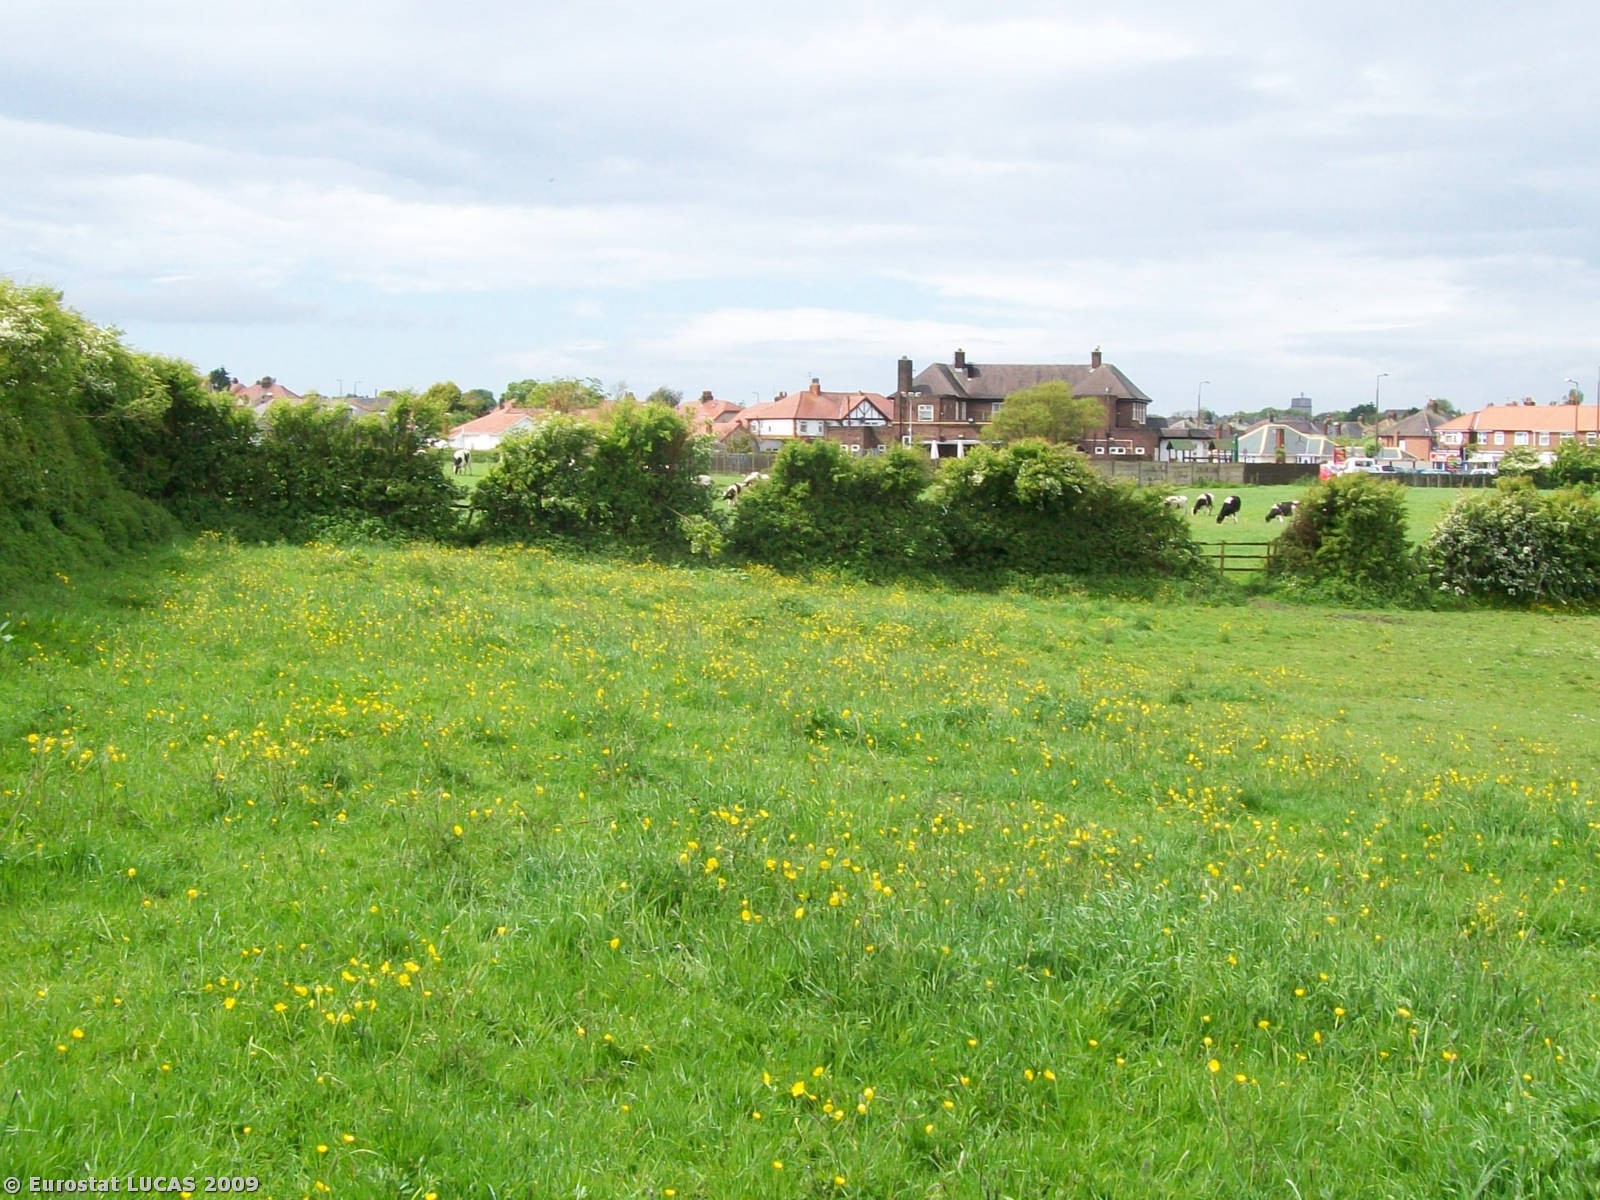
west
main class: Grassland
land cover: Grassland without tree/shrub cover
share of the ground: > 75 %
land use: Agriculture (excluding fallow land and kitchen gardens)
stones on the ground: < 10 %
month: May
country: GB
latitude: 53.8269
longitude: -3.0027
